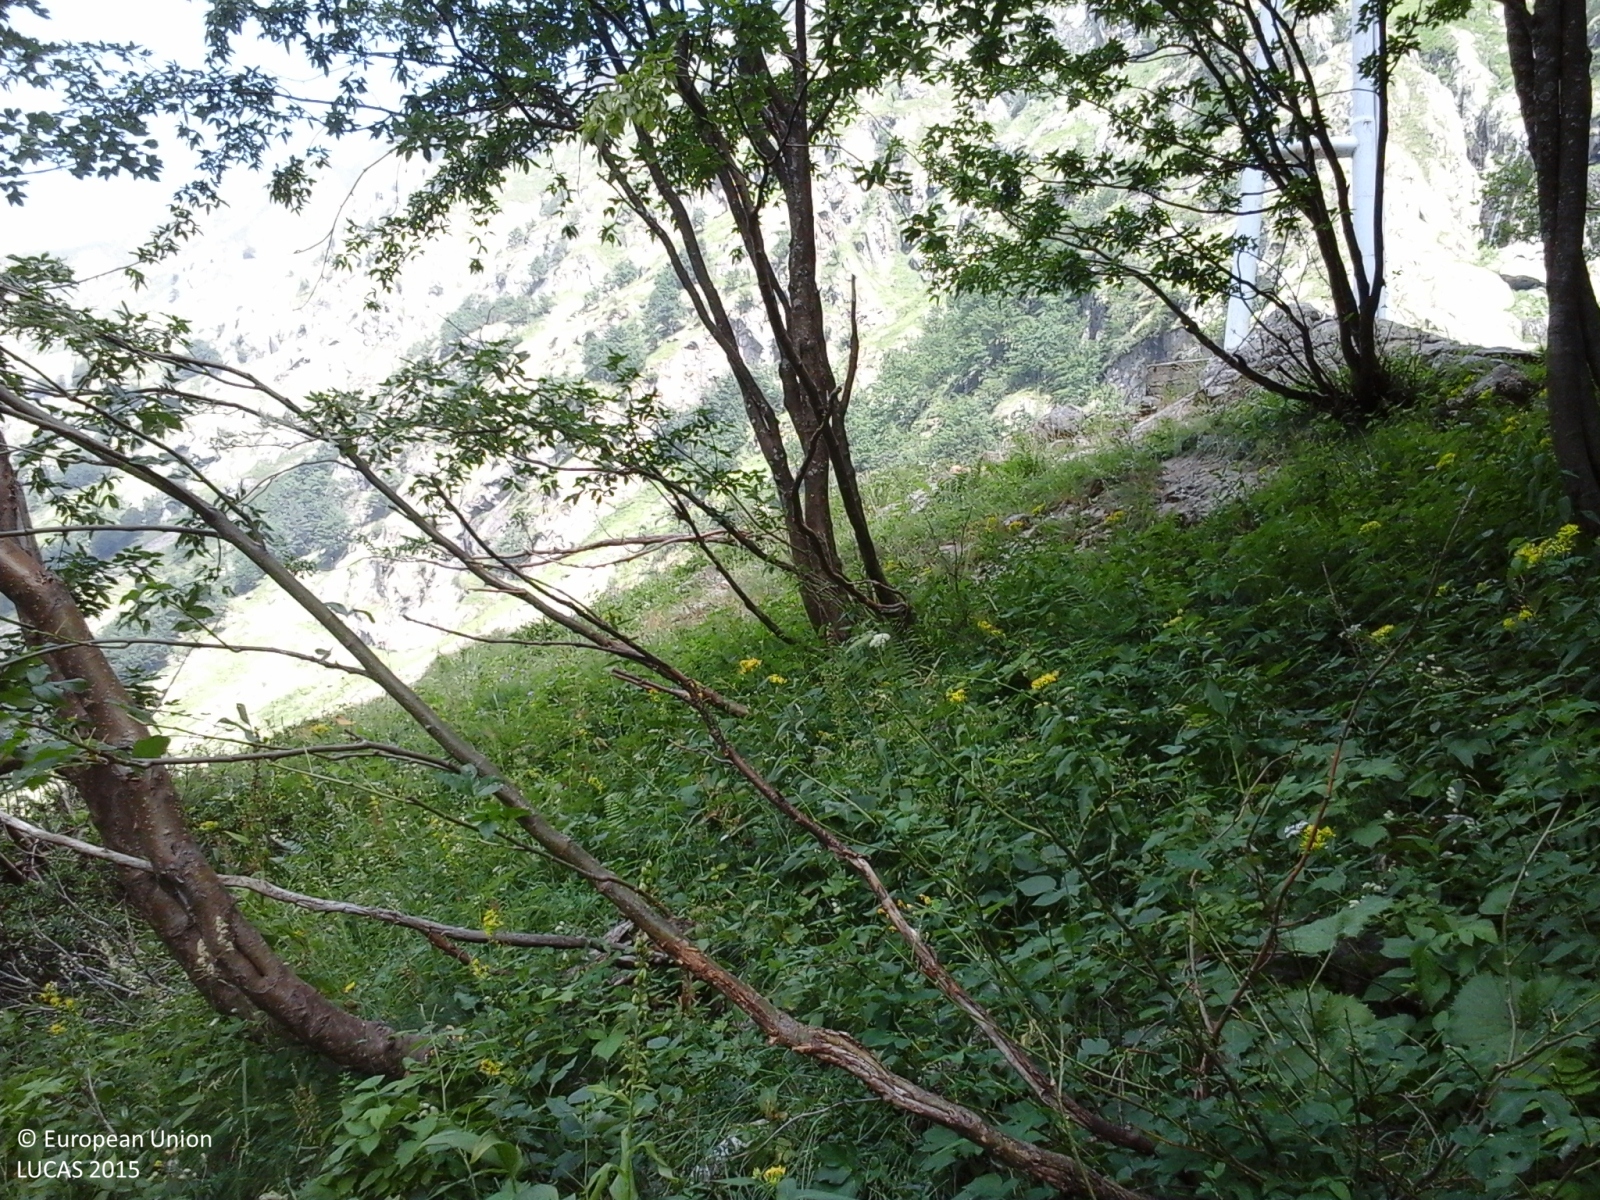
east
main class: Woodland
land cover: Broadleaved woodland
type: mountainous beech forest
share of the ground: 50 - 75 %
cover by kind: broadleaved forest trees 60 %, shrubs 20 %, consolidated bare surface 20 %
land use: Semi-natural and natural areas not in use
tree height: > 5 m
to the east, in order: Broadleaved woodland; Grassland without tree/shrub cover; Tracks; Grassland without tree/shrub cover; Rivers and streams; Grassland without tree/shrub cover; Rivers and streams; Rocks and stones; Rivers and streams; Rocks and stones
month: July
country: IT
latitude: 44.1722
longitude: 7.3418
